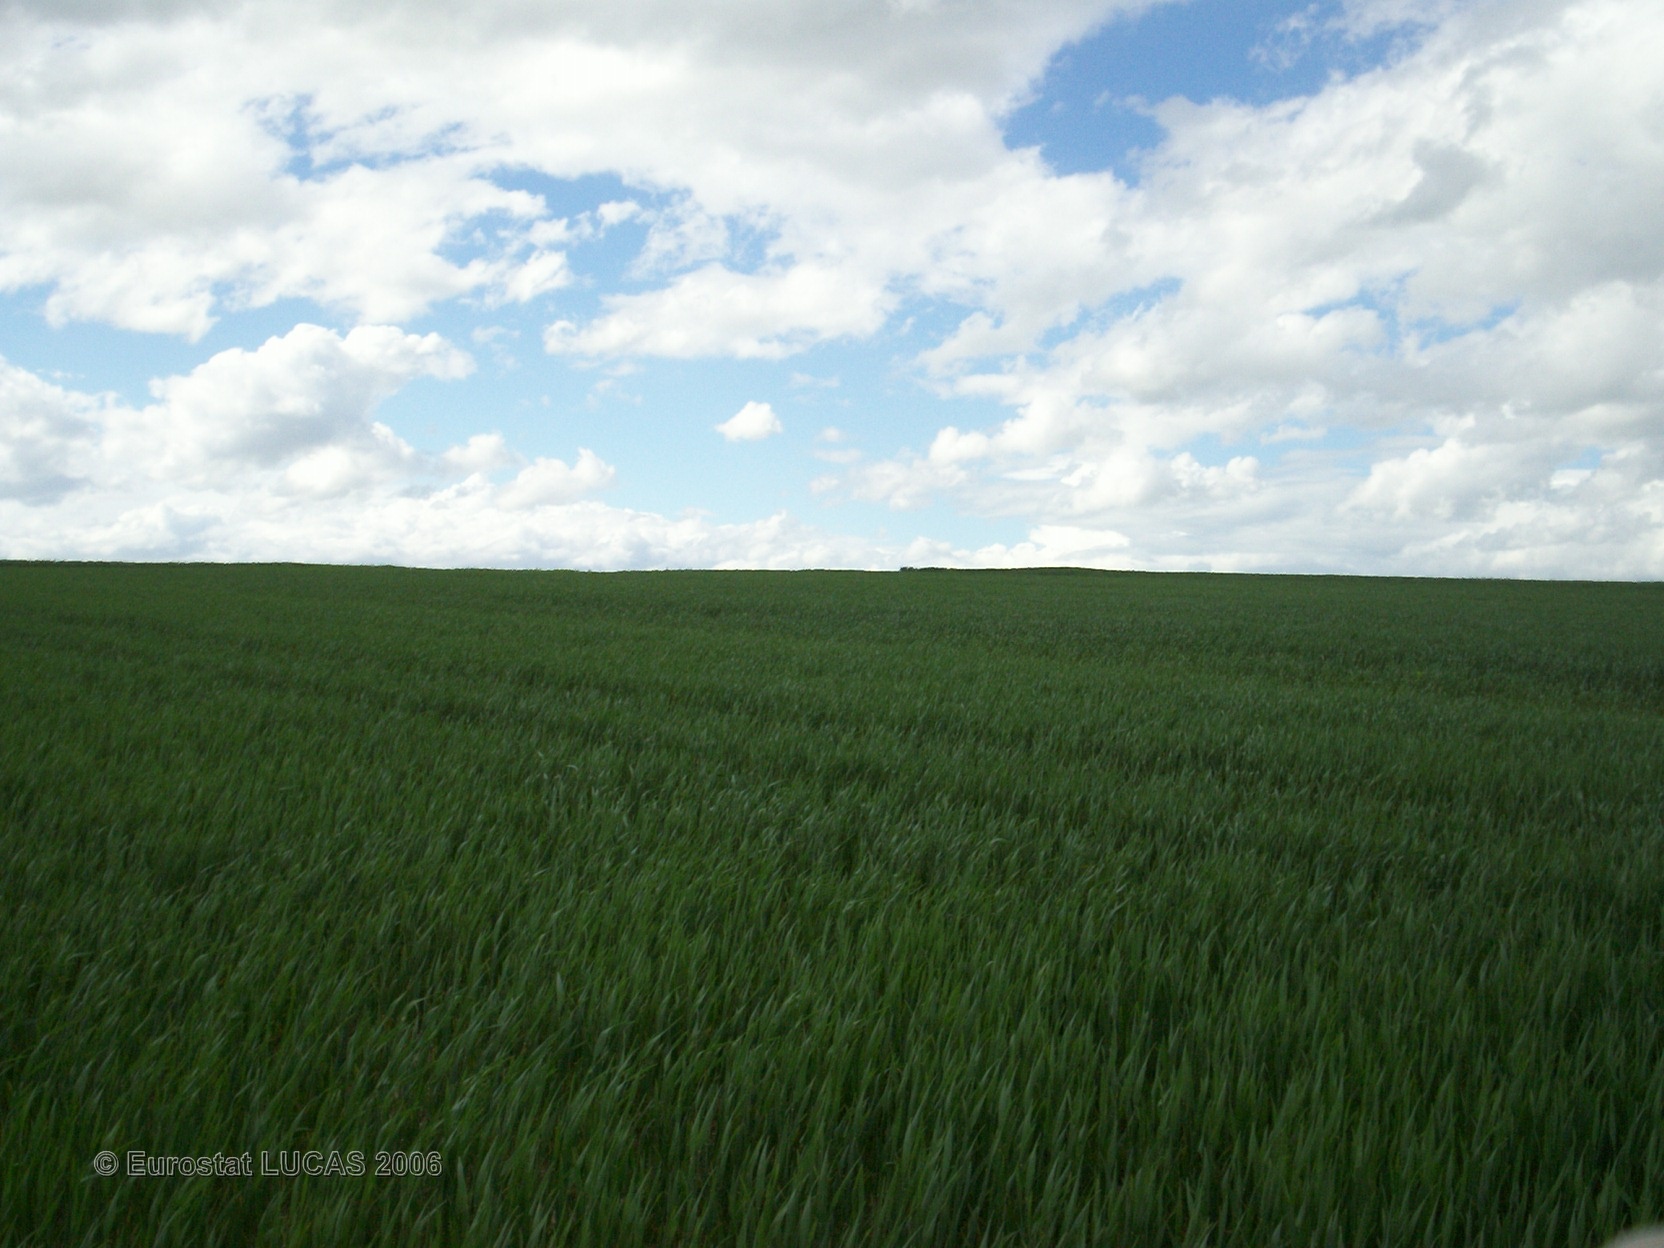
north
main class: Cropland
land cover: Common wheat
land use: Agriculture (excluding fallow land and kitchen gardens)
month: May
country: FR
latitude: 49.3527
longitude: 4.5863
